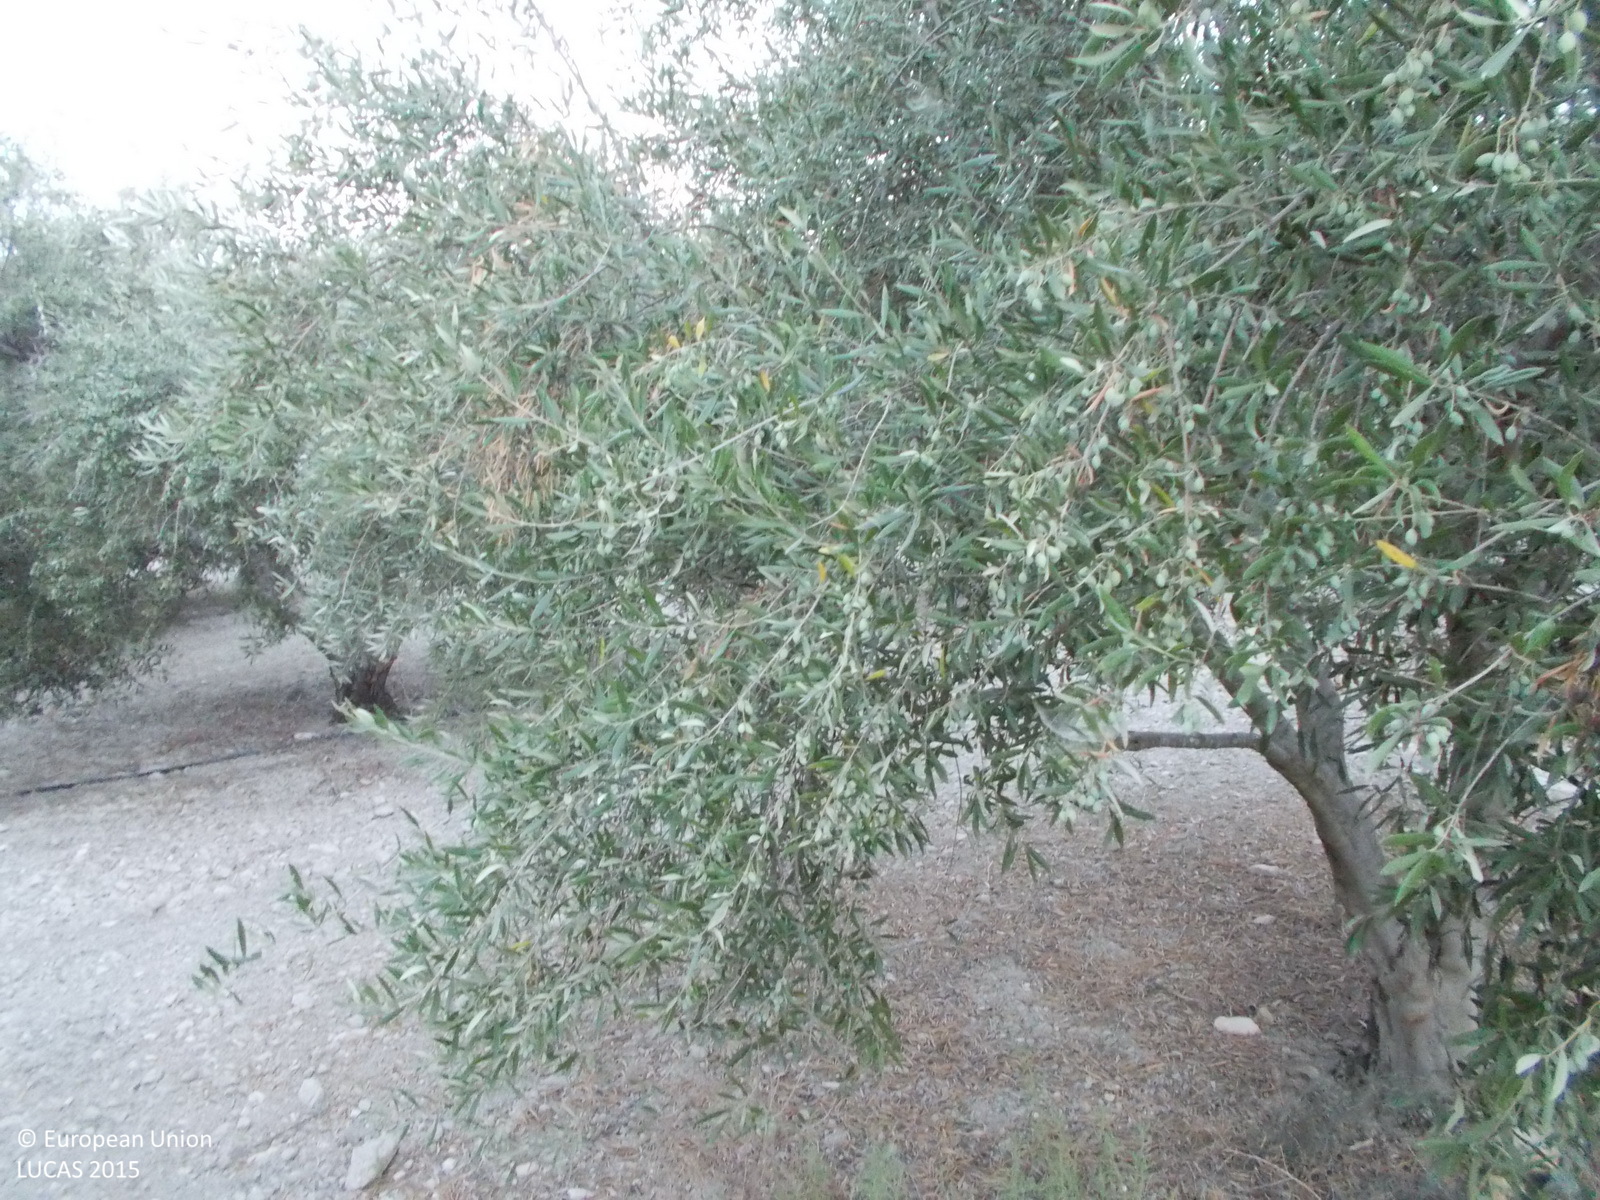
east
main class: Cropland
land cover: Olive groves
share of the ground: > 75 %
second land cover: Other bare soil
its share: > 75 %
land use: Agriculture (excluding fallow land and kitchen gardens)
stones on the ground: < 10 %
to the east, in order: Olive groves; Other bare soil; Tracks; Shrubland without tree cover; Spontaneously vegetated surfaces; Grassland with sparse tree/shrub cover; Broadleaved woodland; Oranges; Spontaneously vegetated surfaces
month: May
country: CY
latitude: 34.7879
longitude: 33.3150
